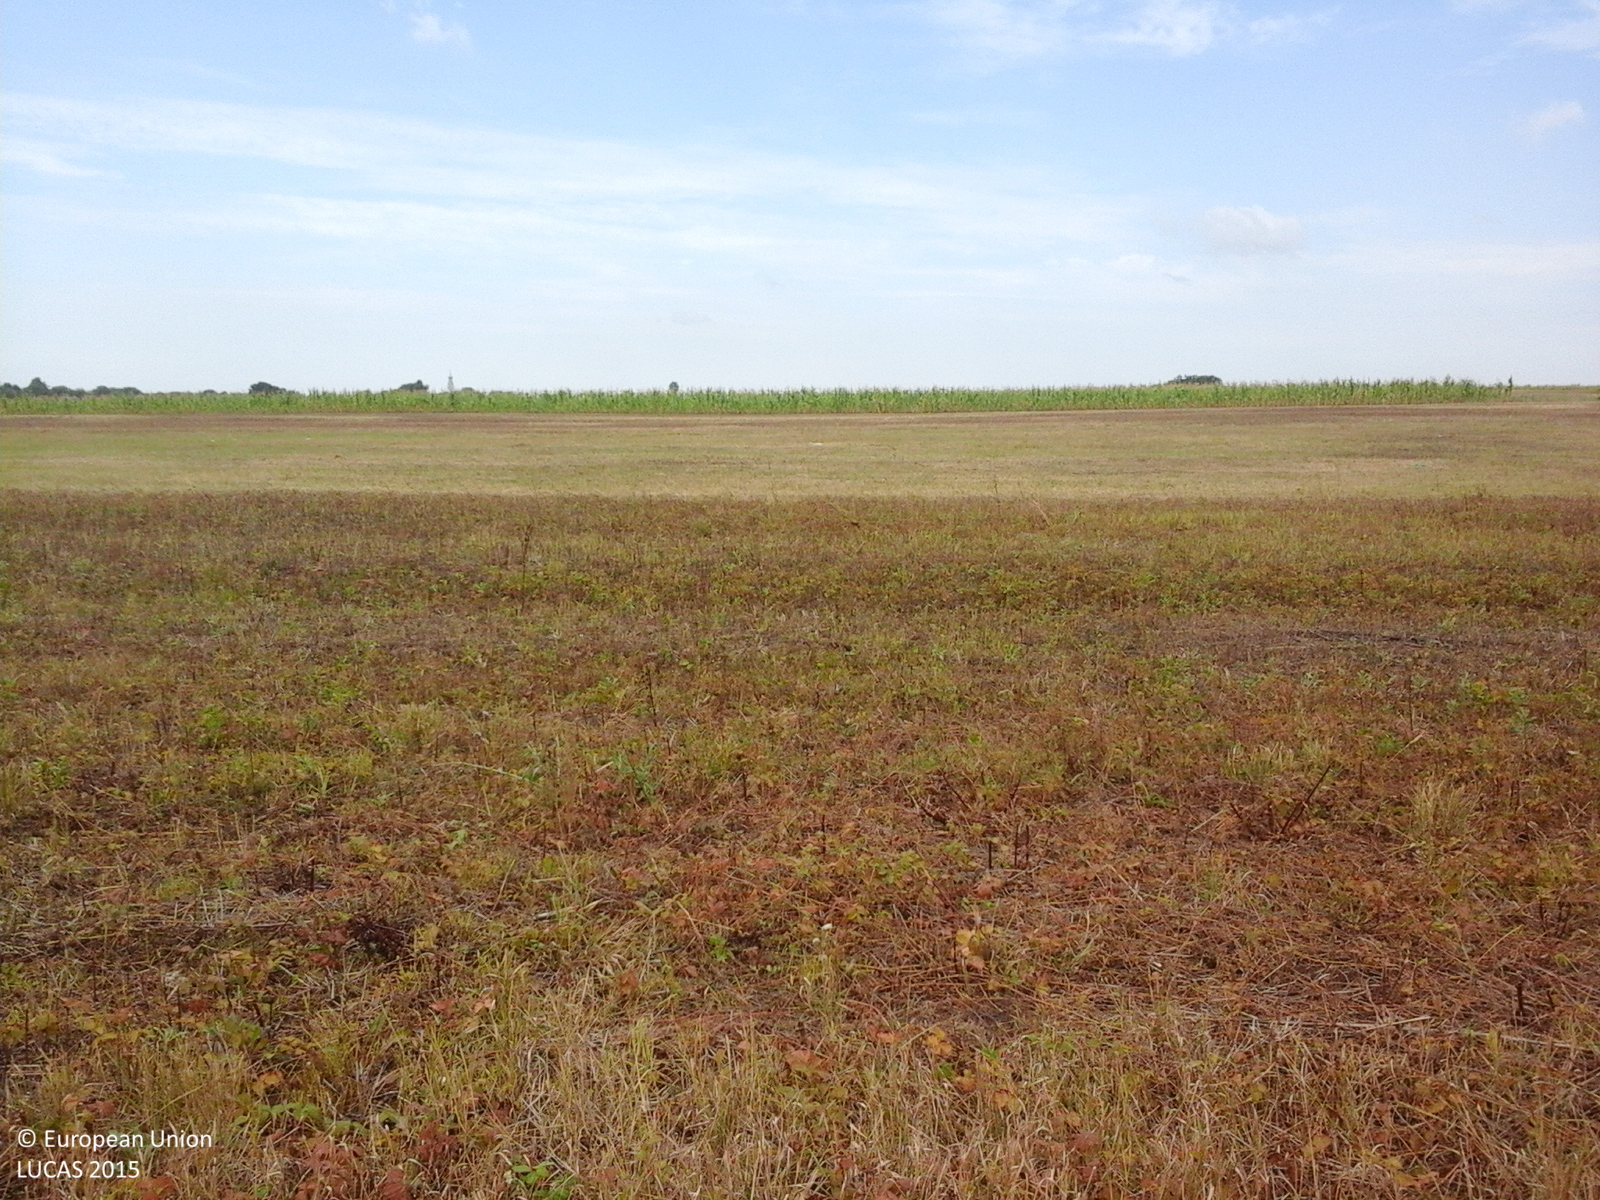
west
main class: Grassland
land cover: Grassland without tree/shrub cover
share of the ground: > 75 %
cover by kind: herbaceous plants 100 %
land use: Agriculture (excluding fallow land and kitchen gardens)
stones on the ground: < 10 %
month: August
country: RO
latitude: 45.0110
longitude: 21.4096
